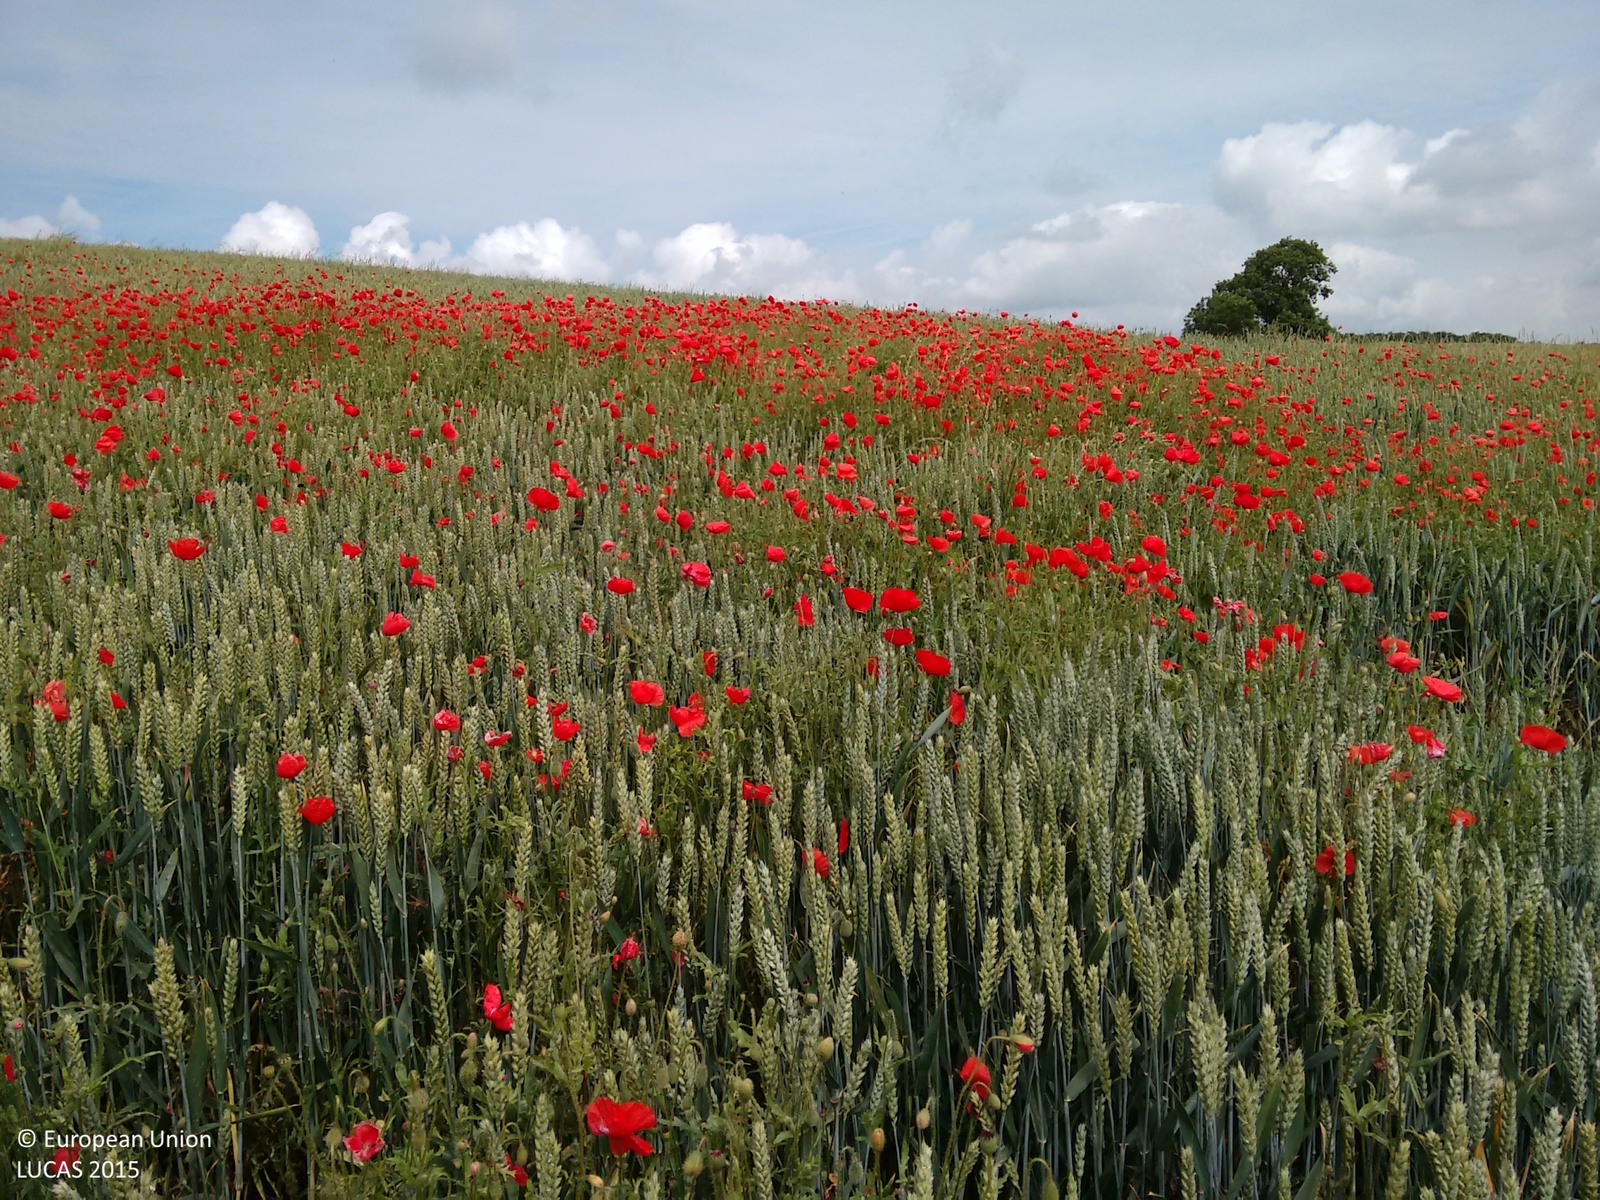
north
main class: Cropland
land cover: Common wheat
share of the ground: > 75 %
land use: Agriculture (excluding fallow land and kitchen gardens)
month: June
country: GB
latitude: 52.9851
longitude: -1.0523
